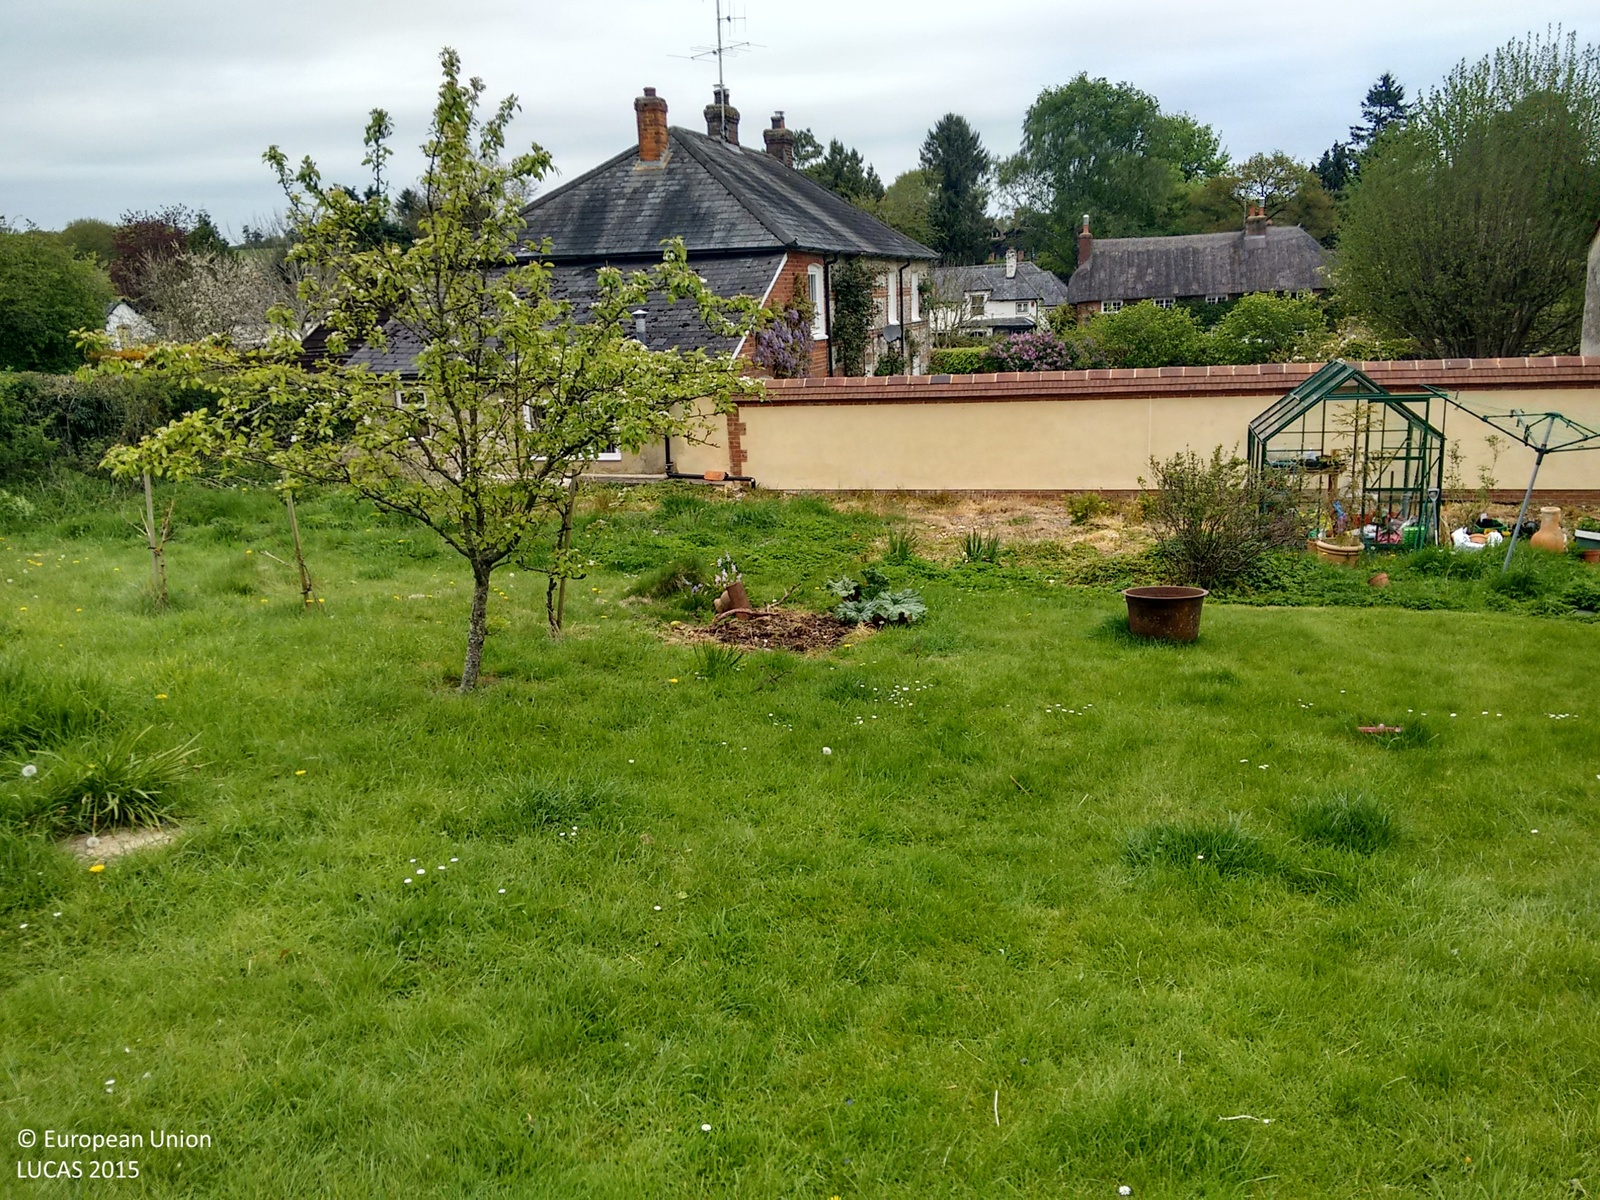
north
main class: Grassland
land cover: Grassland with sparse tree/shrub cover
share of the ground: > 75 %
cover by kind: herbaceous plants 85 %, shrubs 10 %, broadleaved forest trees 5 %
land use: Residential
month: May
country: GB
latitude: 51.3065
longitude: -1.5127
